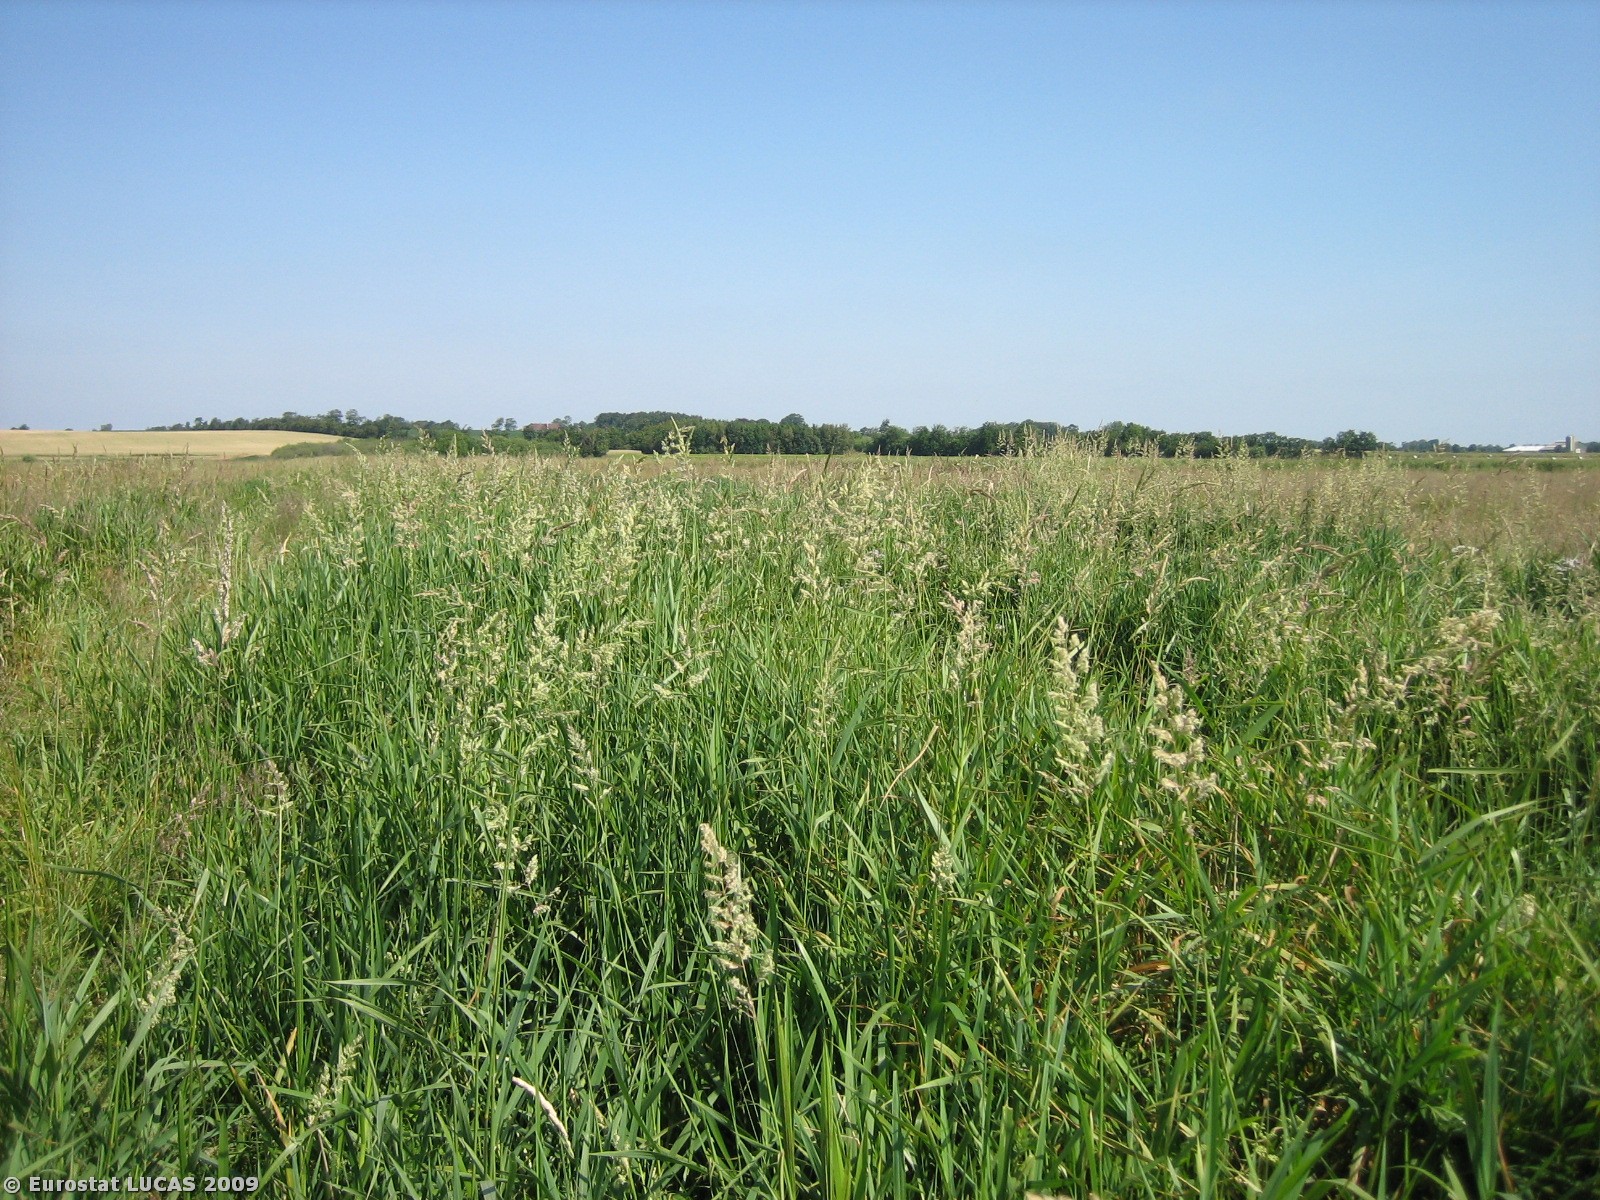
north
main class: Grassland
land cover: Grassland without tree/shrub cover
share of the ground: > 75 %
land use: Agriculture (excluding fallow land and kitchen gardens)
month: July
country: DK
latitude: 55.4093
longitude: 8.8165
